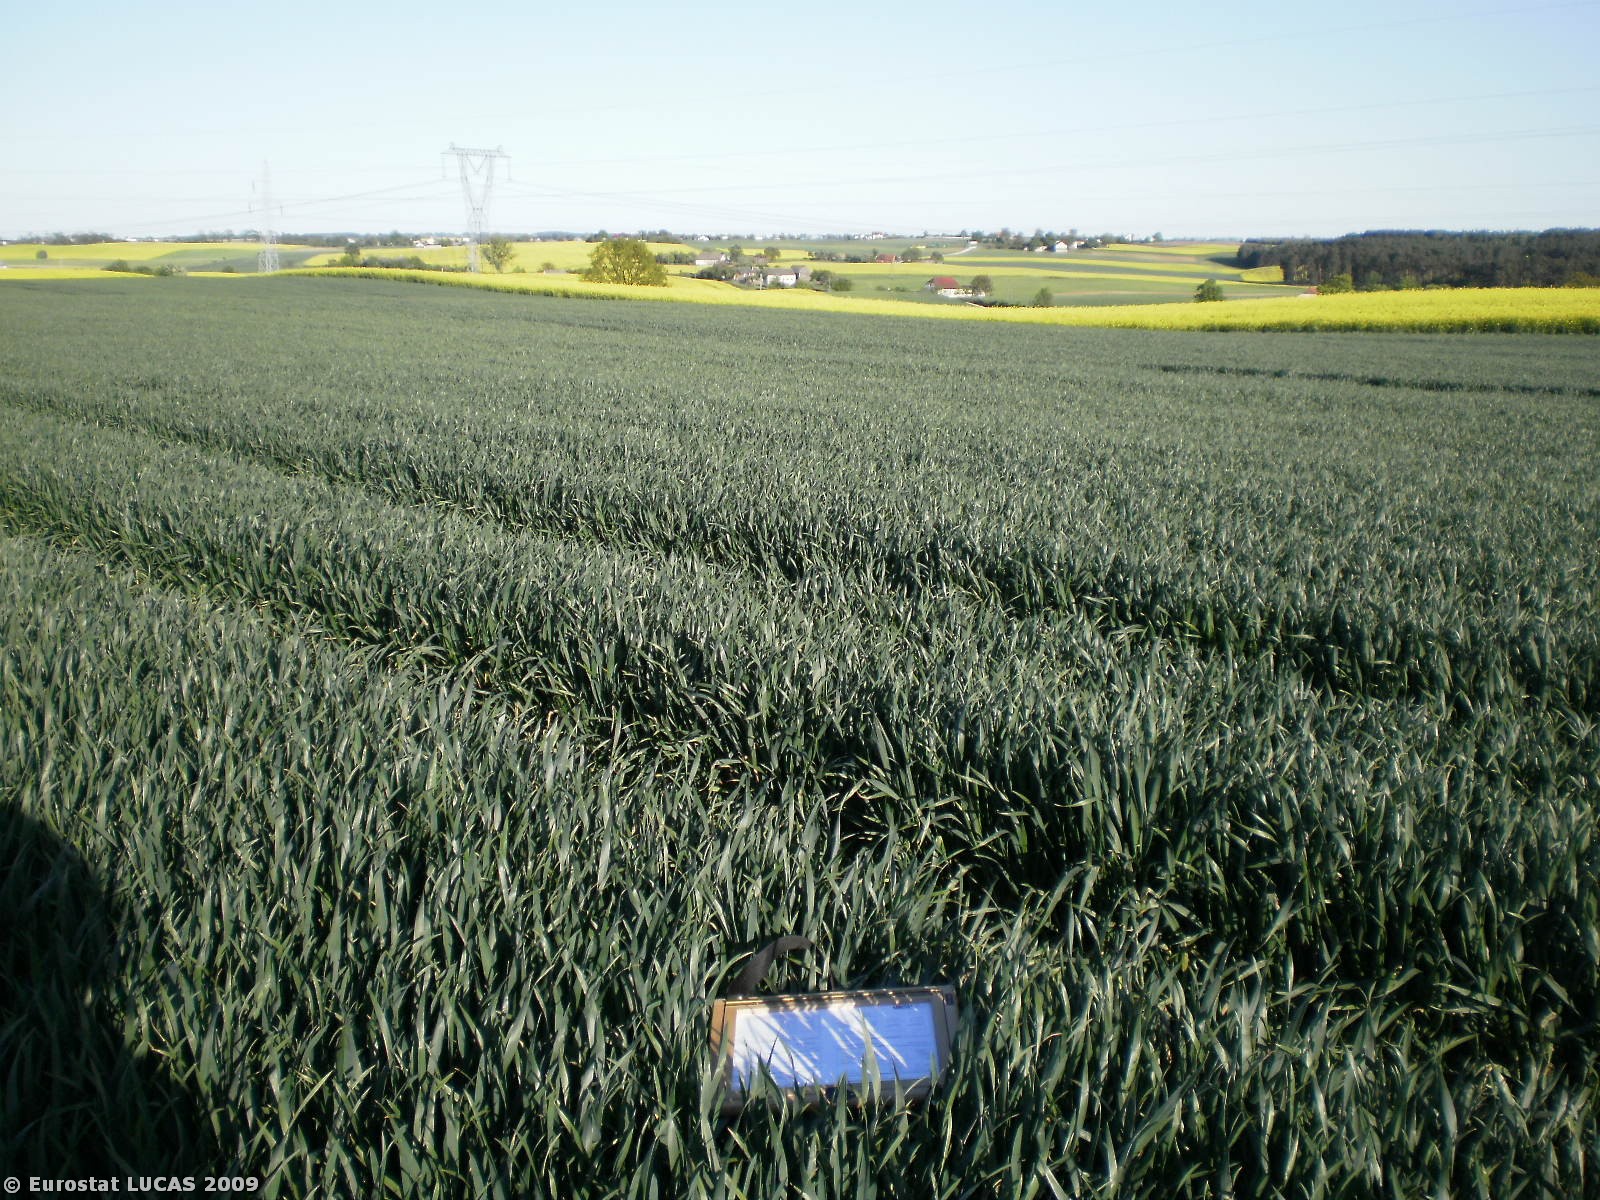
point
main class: Cropland
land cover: Common wheat
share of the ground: > 75 %
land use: Agriculture (excluding fallow land and kitchen gardens)
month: May
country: PL
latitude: 53.4587
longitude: 18.8315
